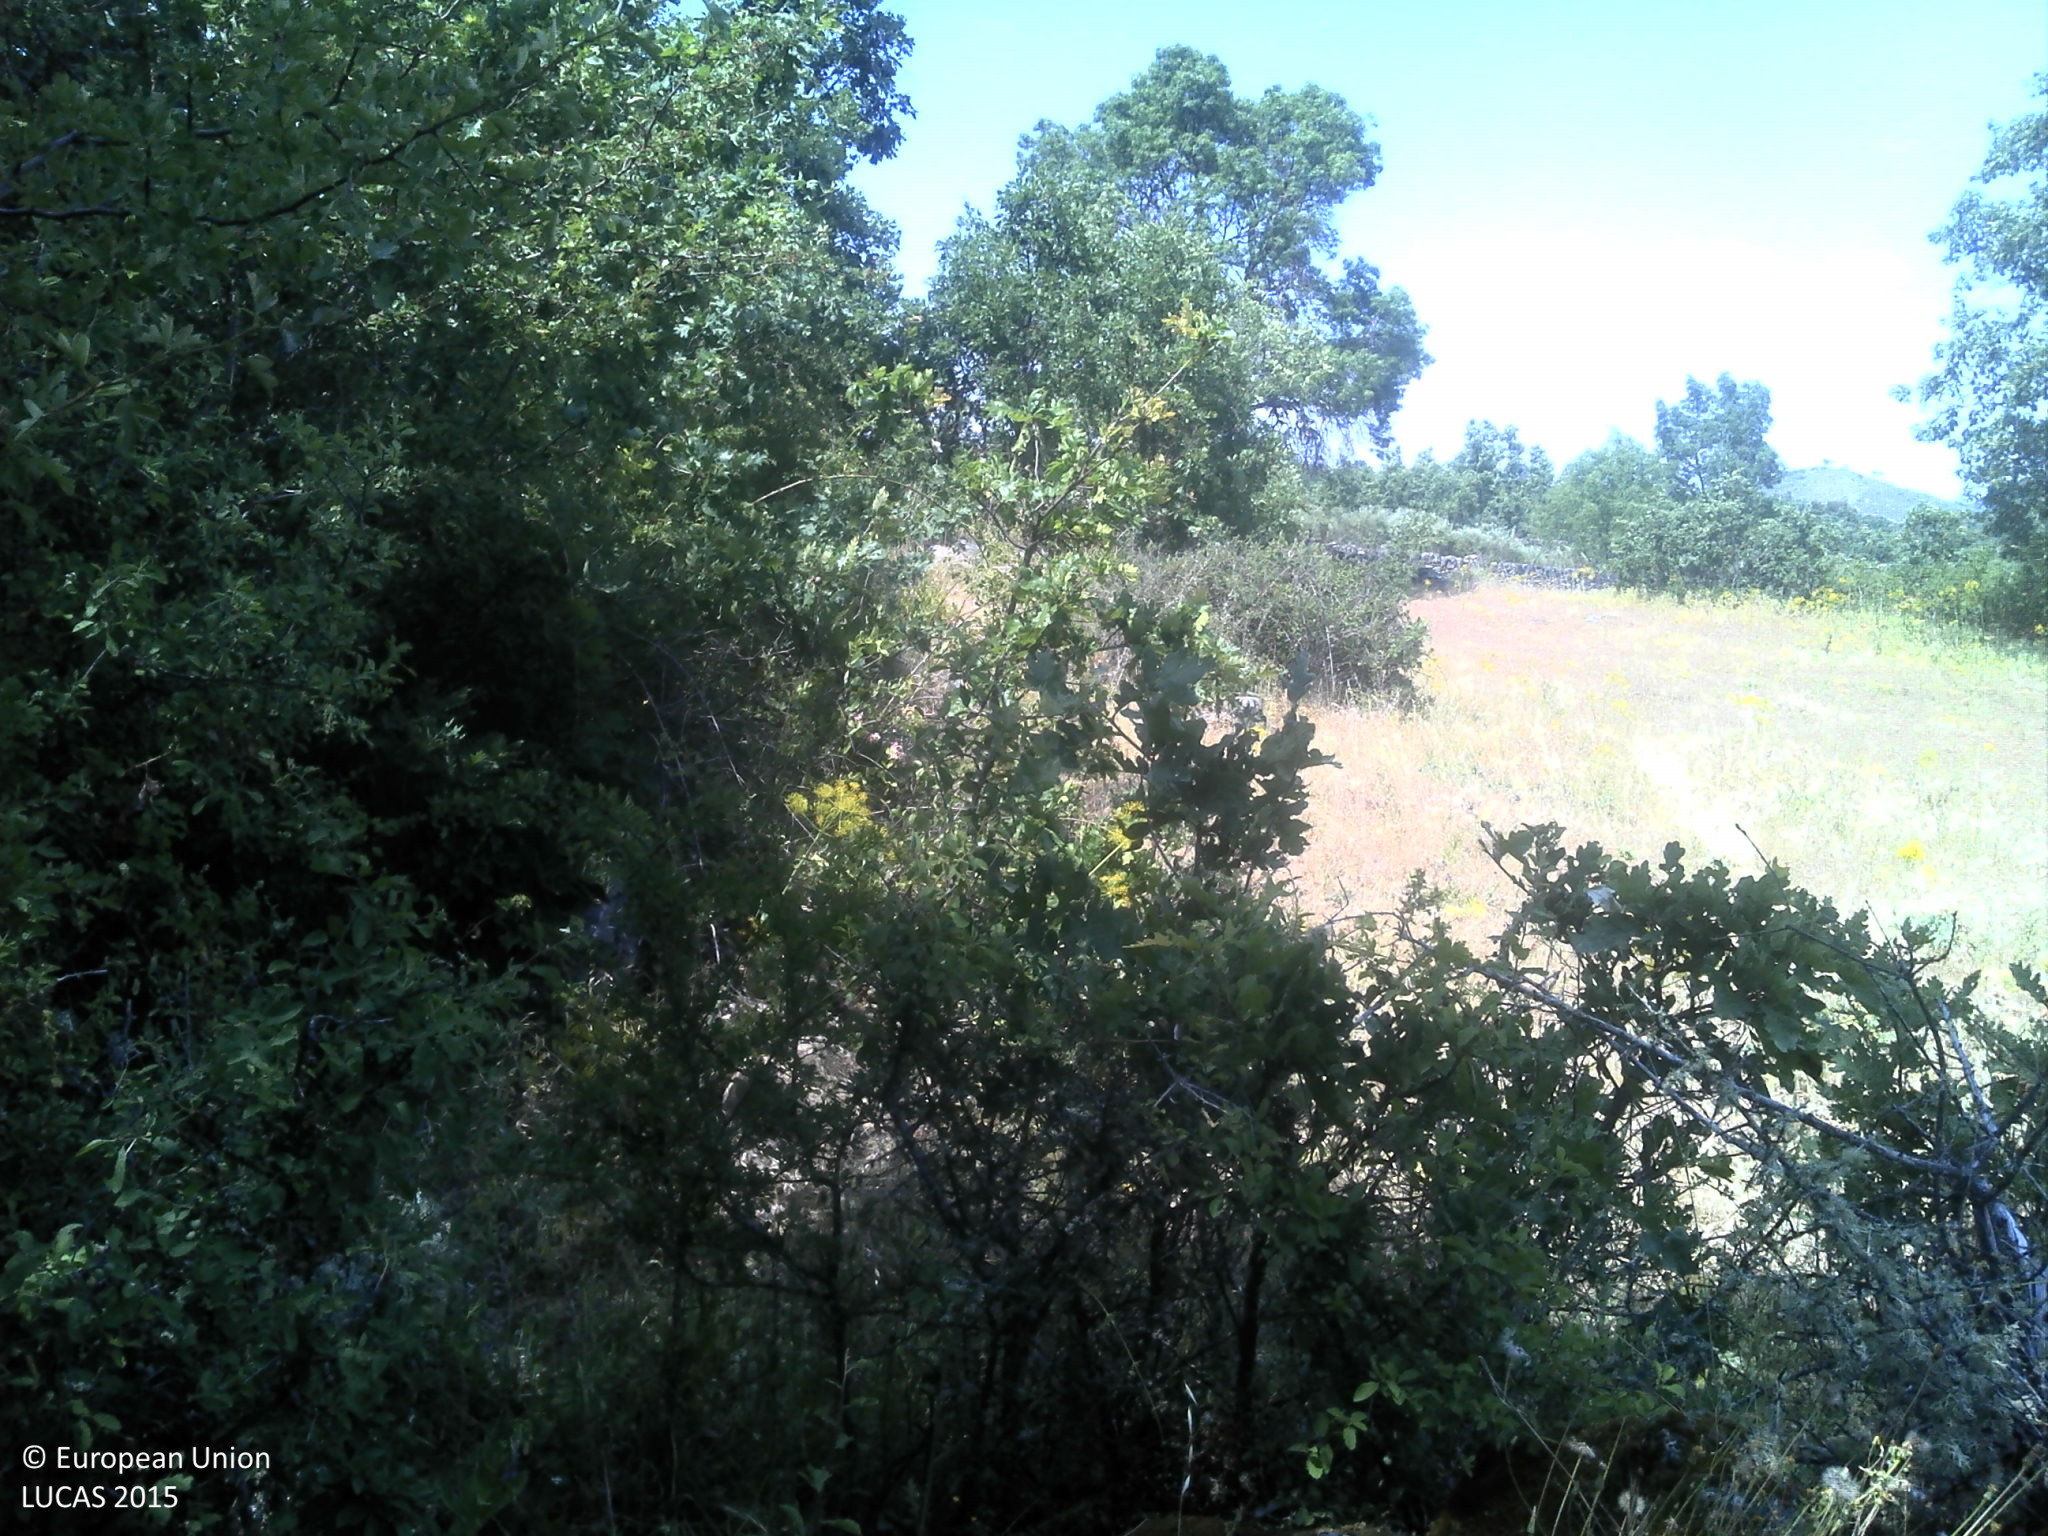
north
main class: Woodland
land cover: Broadleaved woodland
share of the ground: 25 - 50 %
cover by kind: broadleaved forest trees 75 %, shrubs 15 %, herbaceous plants 5 %, unconsolidated bare surface 5 %
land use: Forestry
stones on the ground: 10 - 25 %
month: June
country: PT
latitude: 40.4637
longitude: -7.0223
